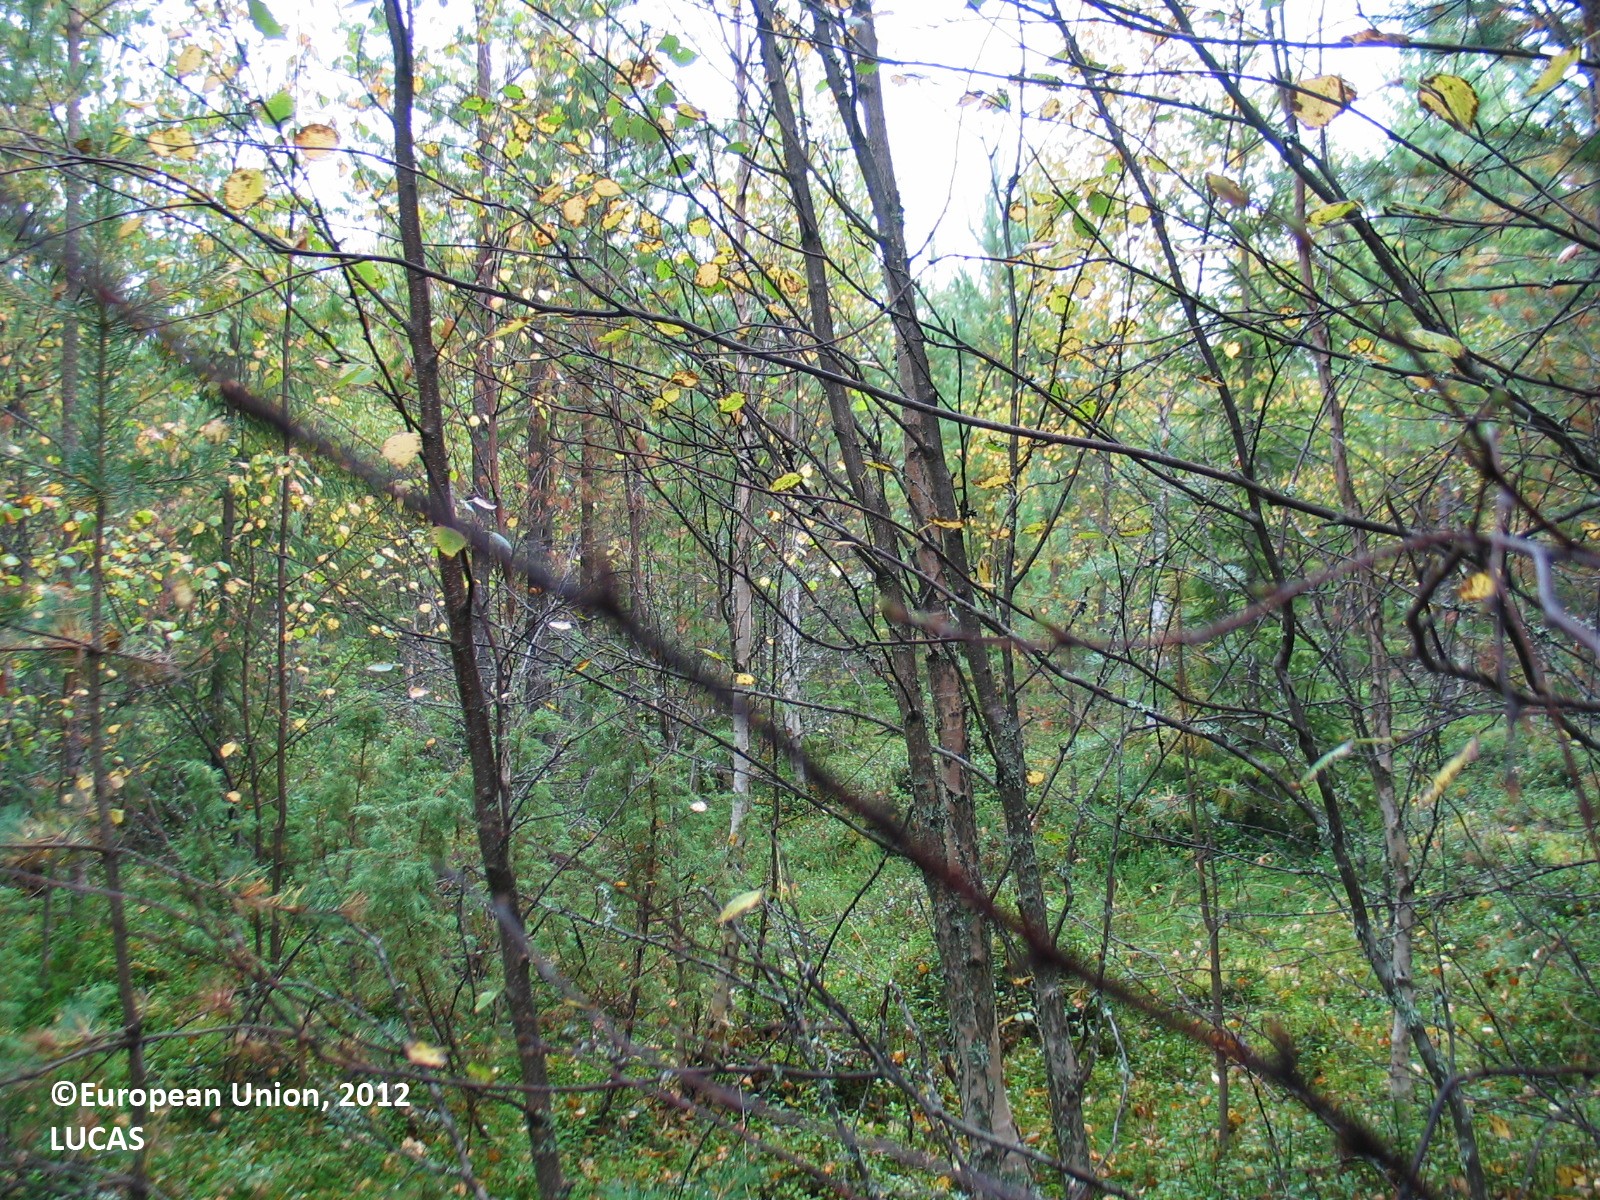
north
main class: Woodland
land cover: Pine dominated mixed woodland
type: boreal forest
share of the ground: 50 - 75 %
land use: Forestry
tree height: > 5 m
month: September
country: FI
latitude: 65.2166
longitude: 25.5396
